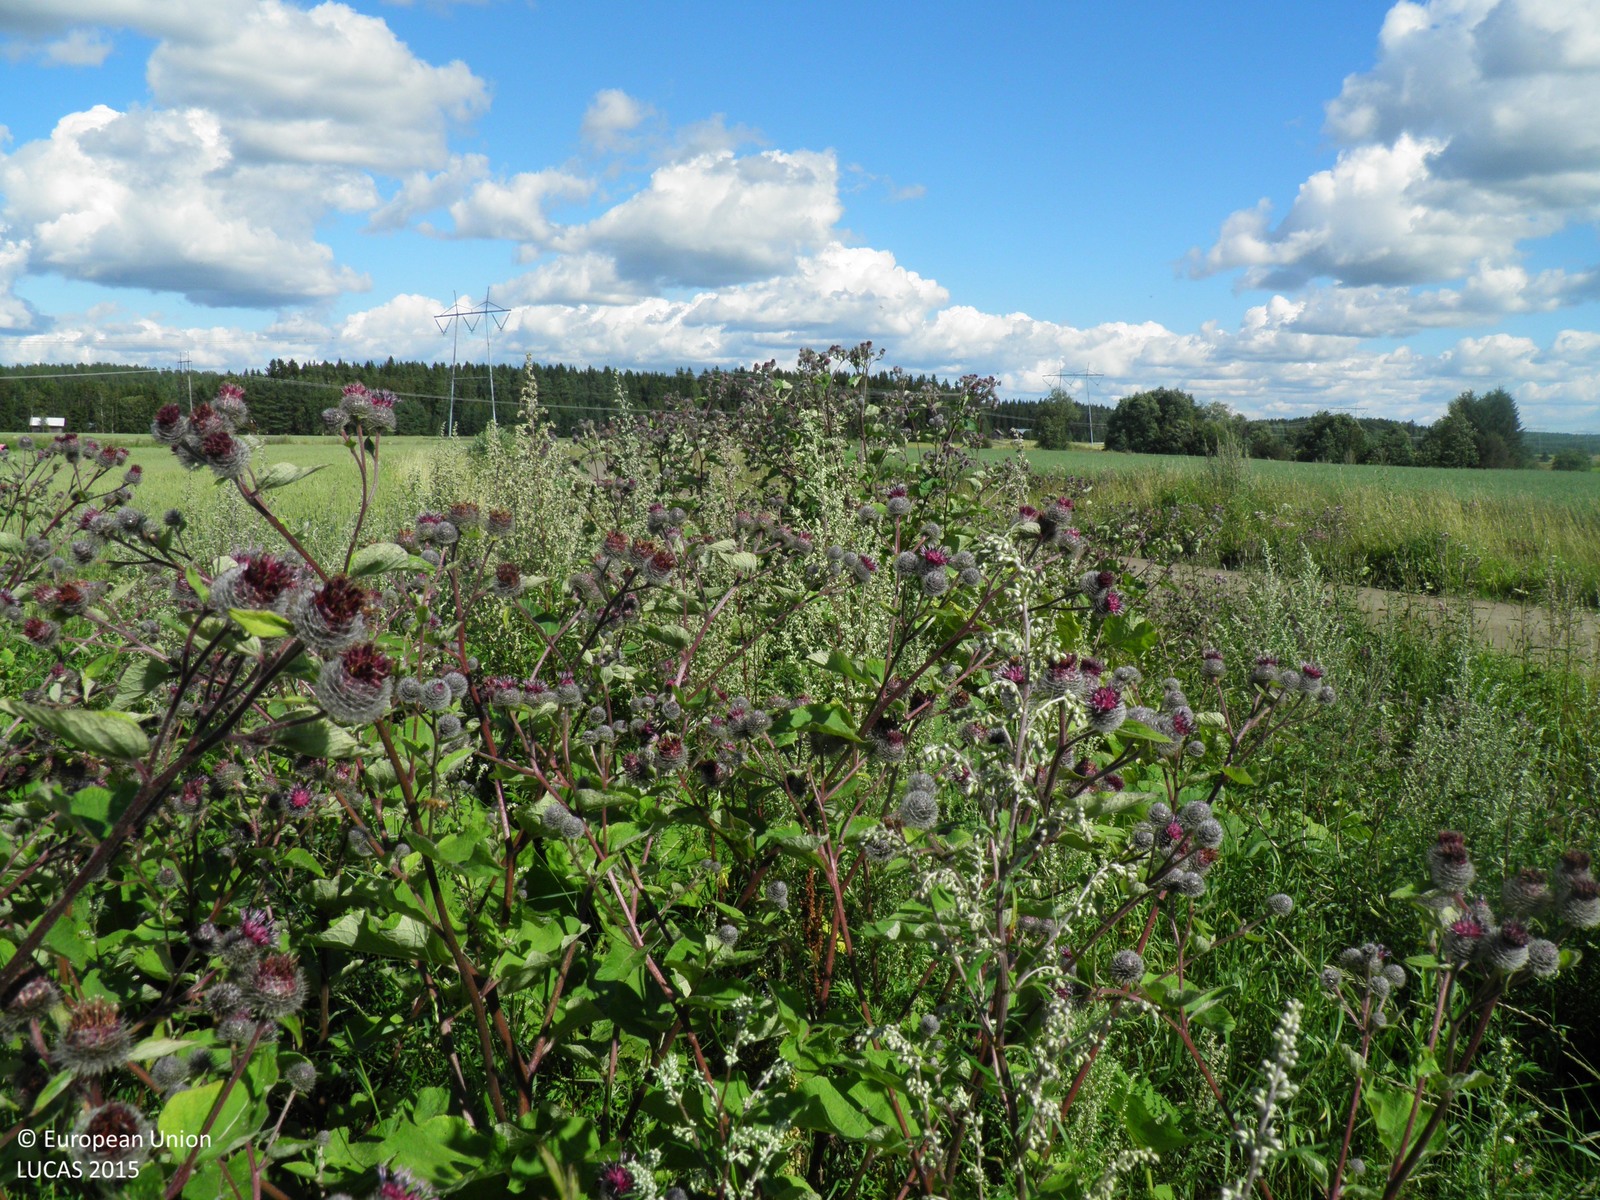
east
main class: Shrubland
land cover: Shrubland without tree cover
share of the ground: > 75 %
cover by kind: shrubs 100 %
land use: Agriculture (excluding fallow land and kitchen gardens)
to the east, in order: Shrubland without tree cover; Tracks; Common wheat; Grass margins; Ditches and canals; Grass margins; Paved roads, cycling and walking lanes; Grass margins; Ditches and canals; Grass margins; Oats; Grass margins; Ditches and canals; Grass margins; Paved roads, cycling and walking lanes; Shruby margins; Ditches and canals; Grass margins; Common wheat
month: August
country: FI
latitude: 60.9746
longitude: 23.1022
